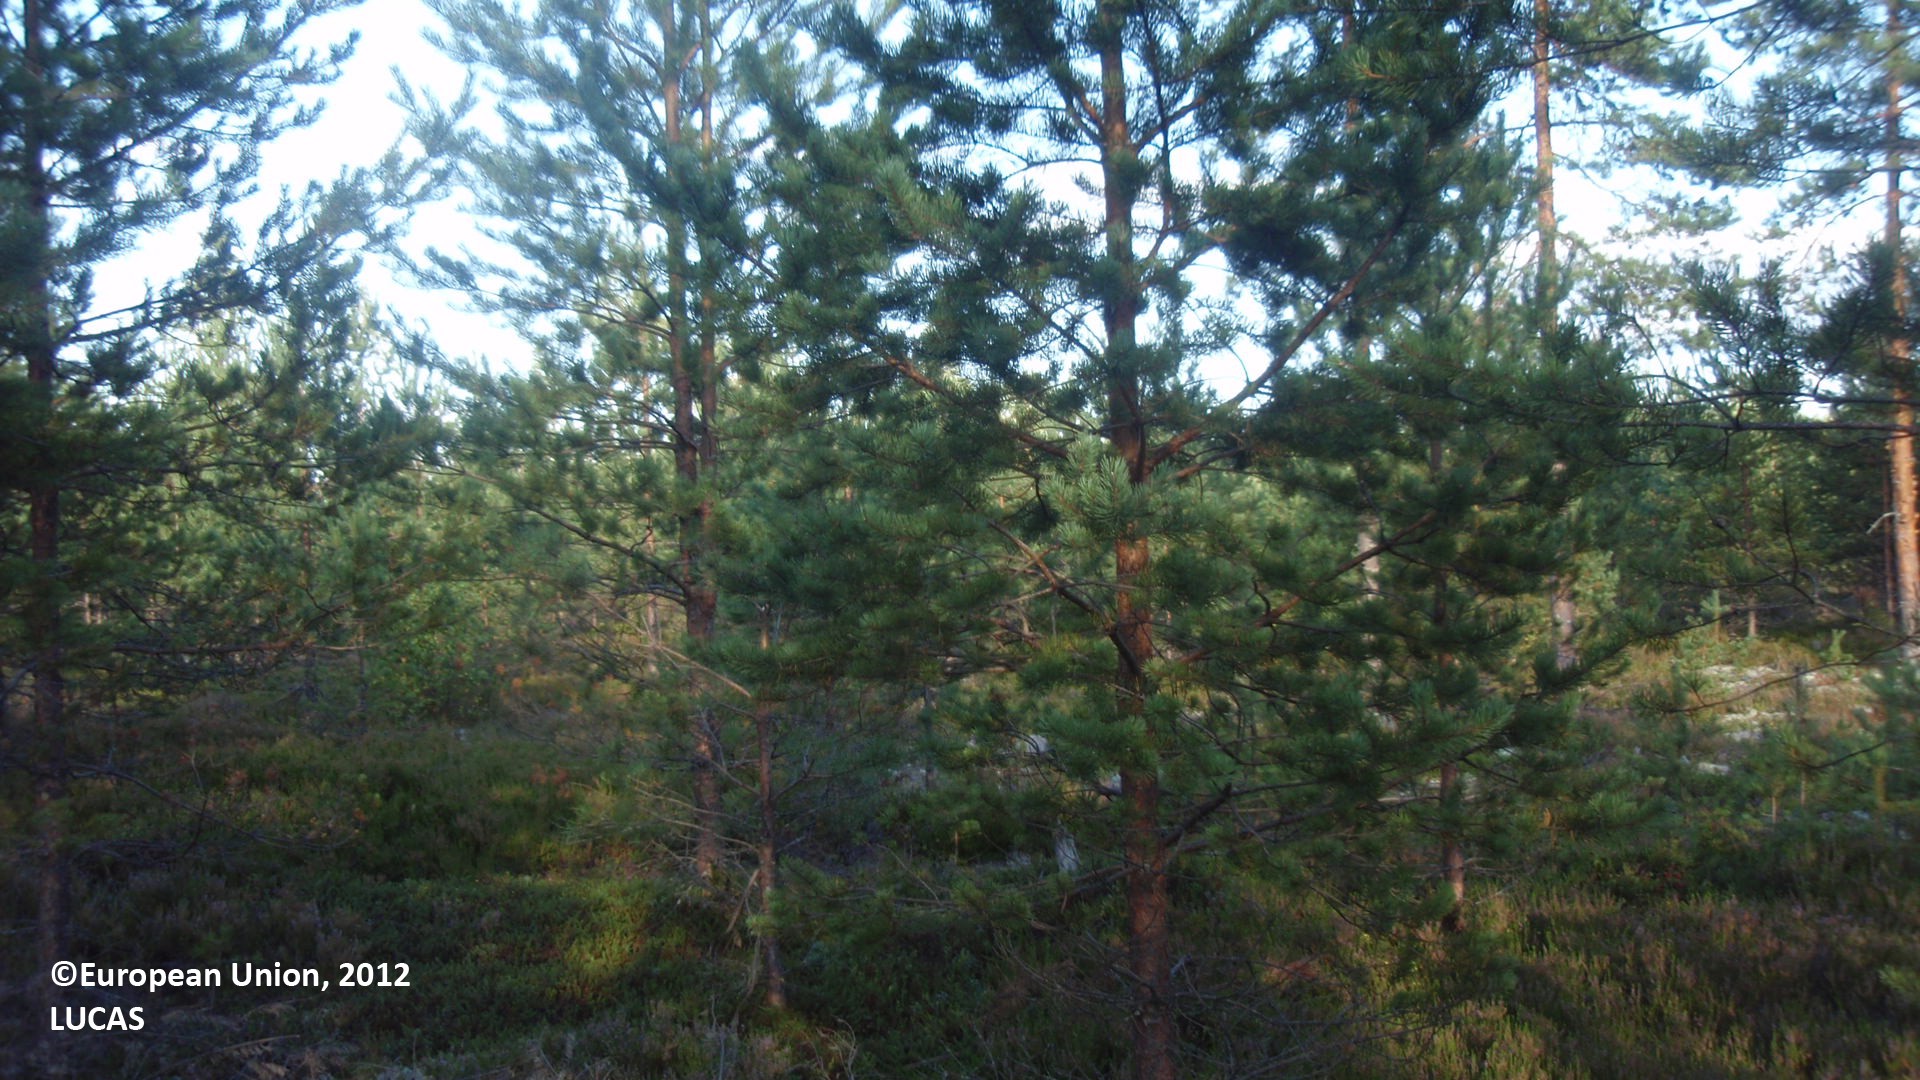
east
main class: Woodland
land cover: Pine dominated coniferous woodland
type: boreal forest
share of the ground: 25 - 50 %
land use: Forestry
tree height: > 5 m
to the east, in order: Pine dominated coniferous woodland; Paved roads, cycling and walking lanes; Shrubland with sparse tree cover; Tracks; Shrubland with sparse tree cover
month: August
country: FI
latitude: 60.8113
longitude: 27.5187
